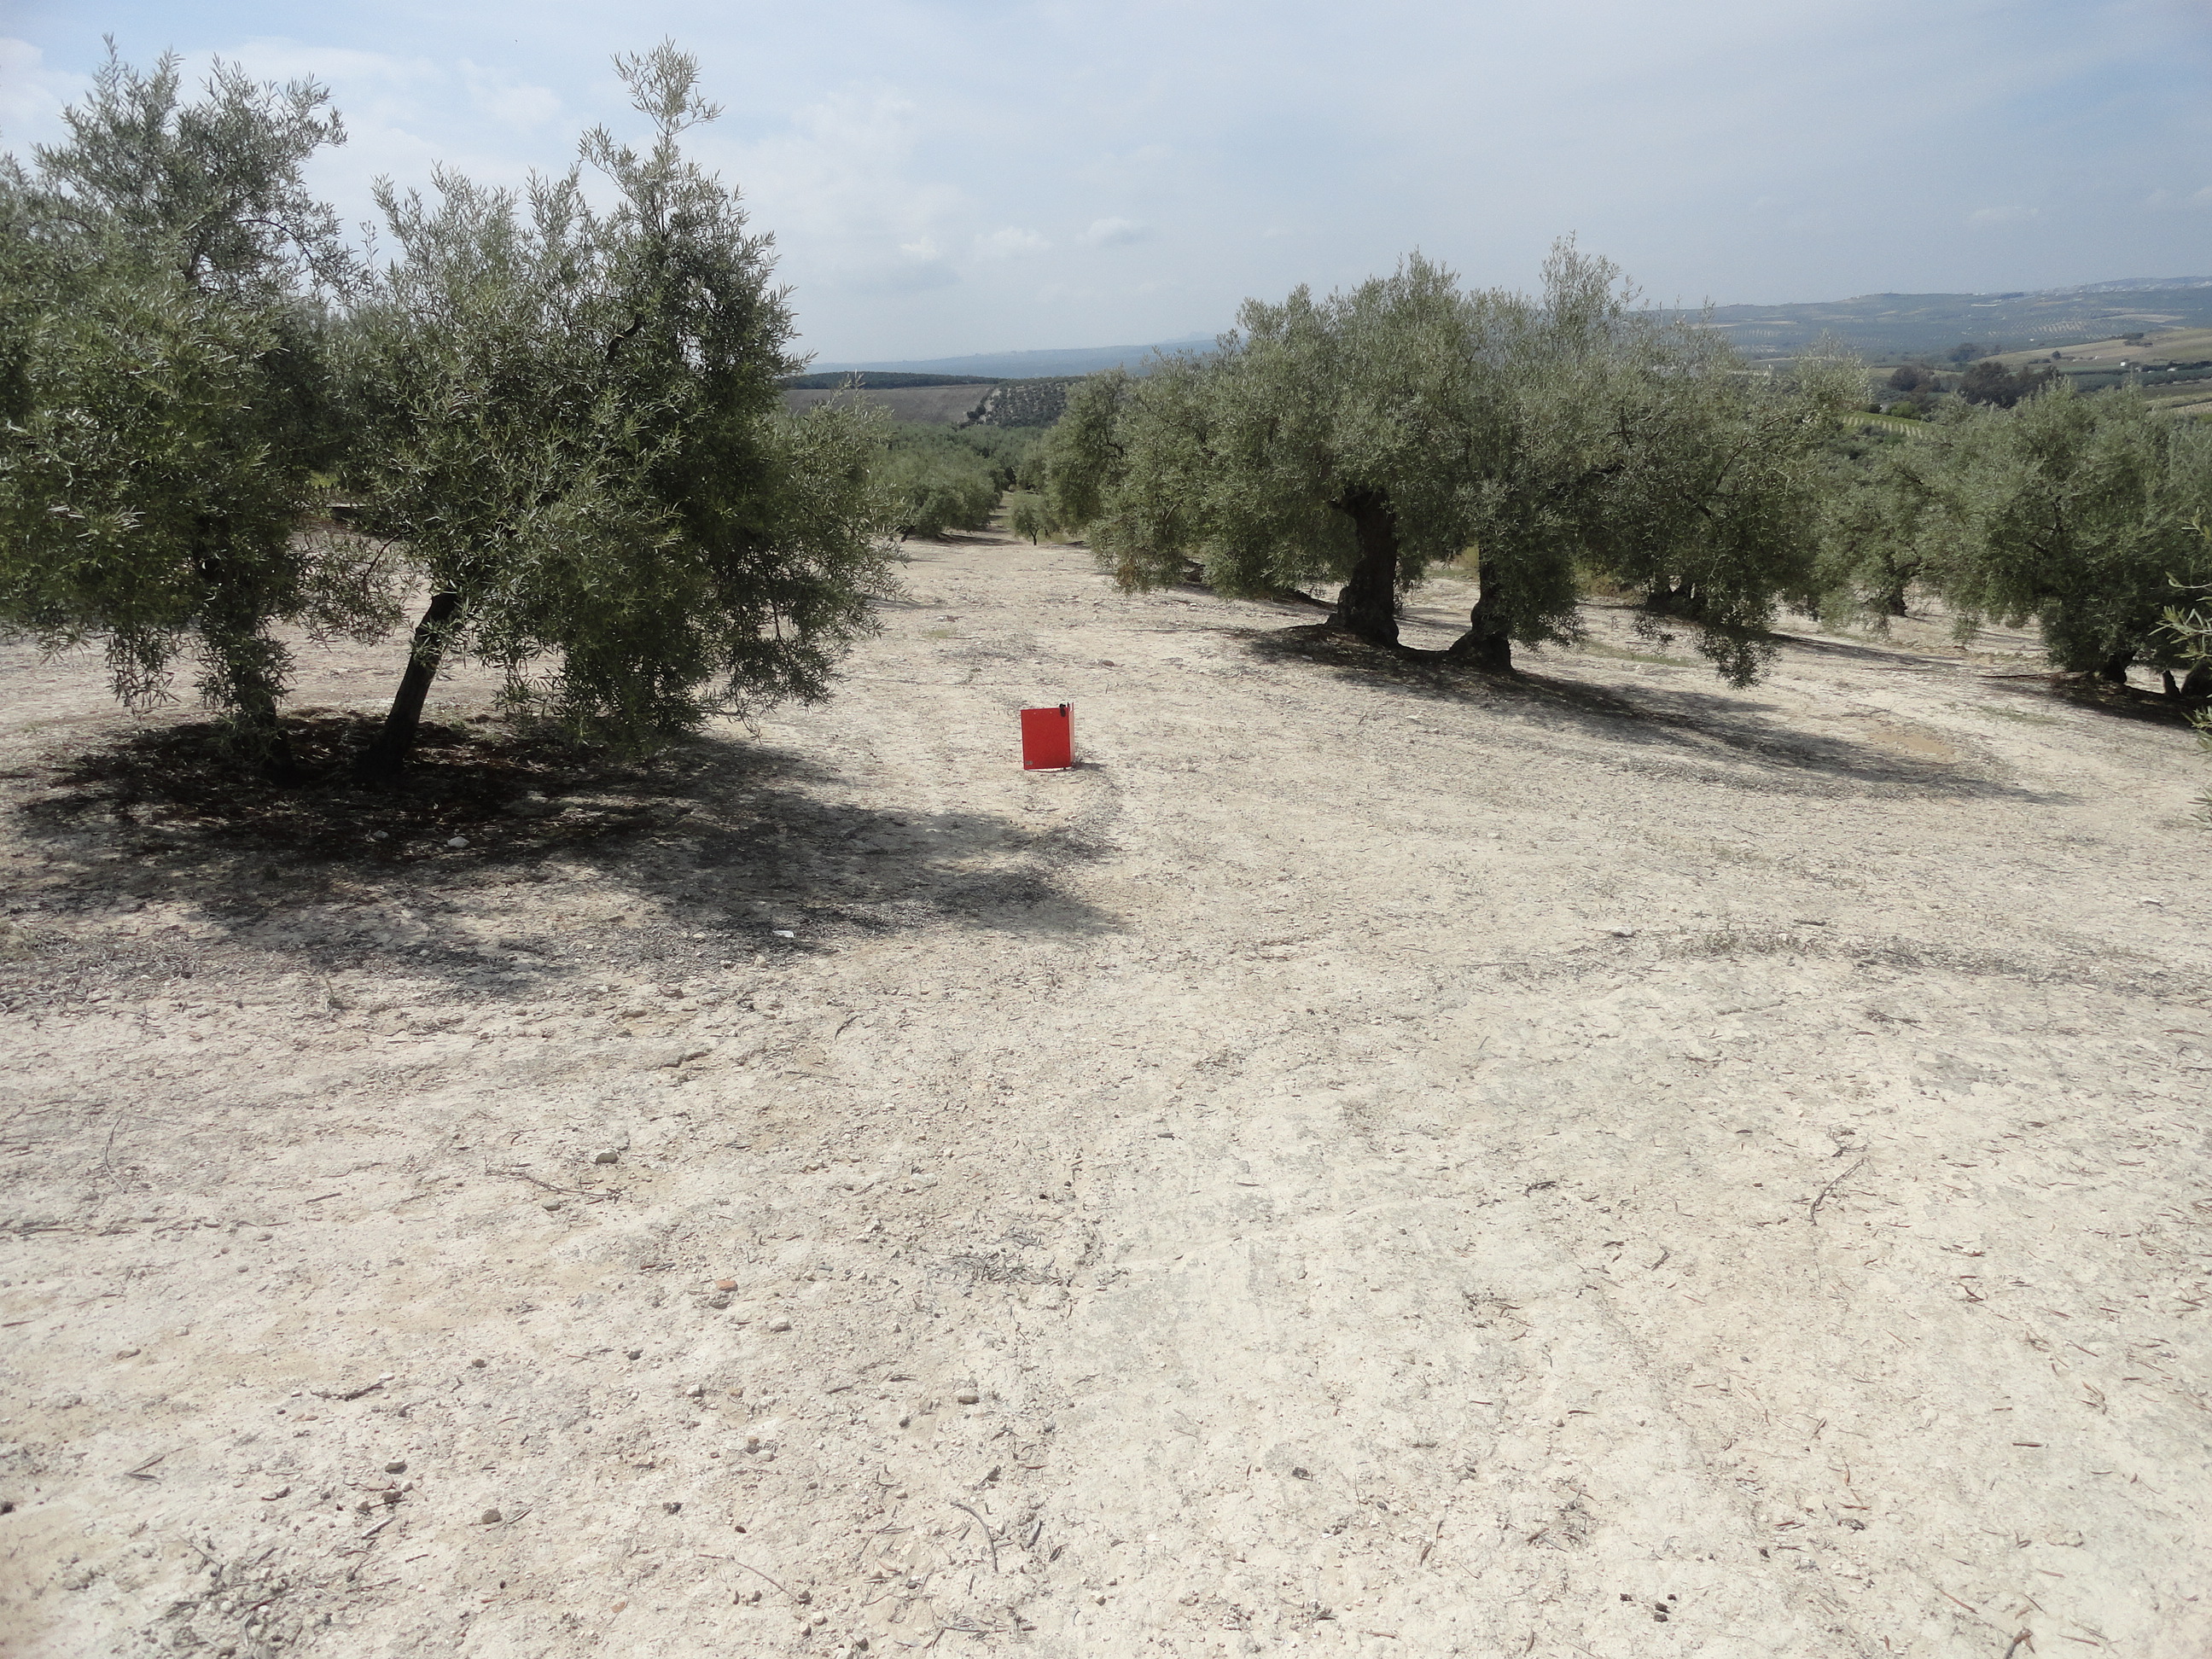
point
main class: Cropland
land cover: Olive groves
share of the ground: 25 - 50 %
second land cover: Other bare soil
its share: > 75 %
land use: Agriculture (excluding fallow land and kitchen gardens)
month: April
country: ES
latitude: 37.5560
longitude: -4.5750
